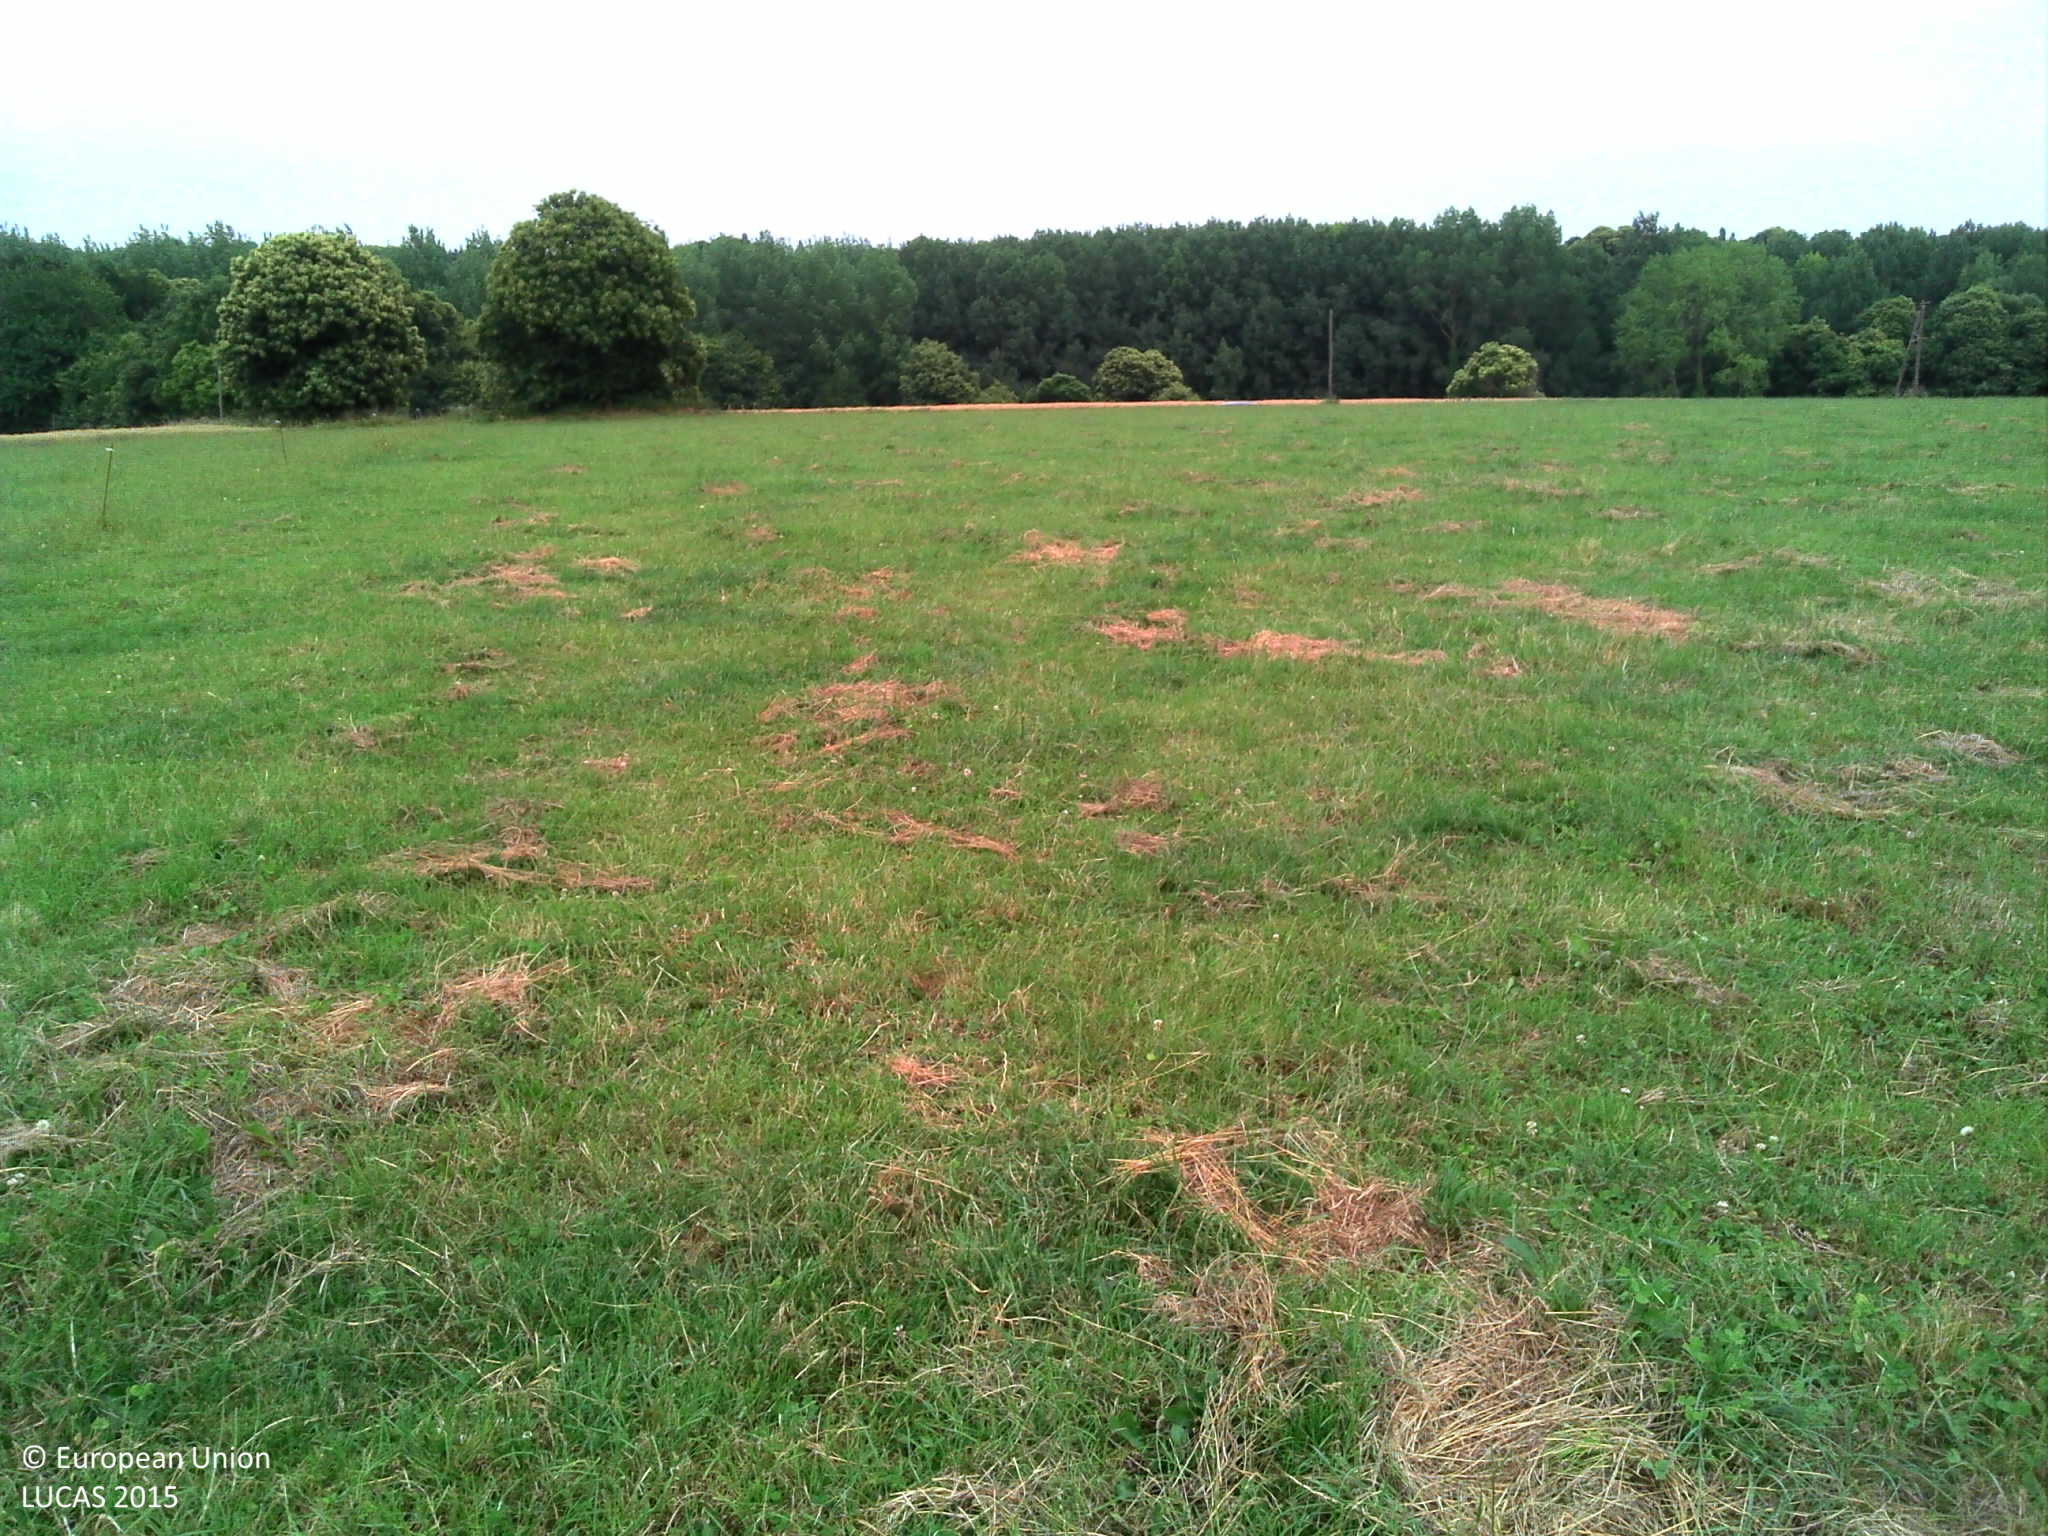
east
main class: Grassland
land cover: Grassland without tree/shrub cover
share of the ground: > 75 %
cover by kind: herbaceous plants 75 %, unconsolidated bare surface 25 %
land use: Agriculture (excluding fallow land and kitchen gardens)
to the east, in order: Grassland without tree/shrub cover; Electric lines; Fences; Grass margins; Paved roads, cycling and walking lanes; Grass margins; Barley; Lines of trees
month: July
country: FR
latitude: 48.5223
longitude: -2.0647
